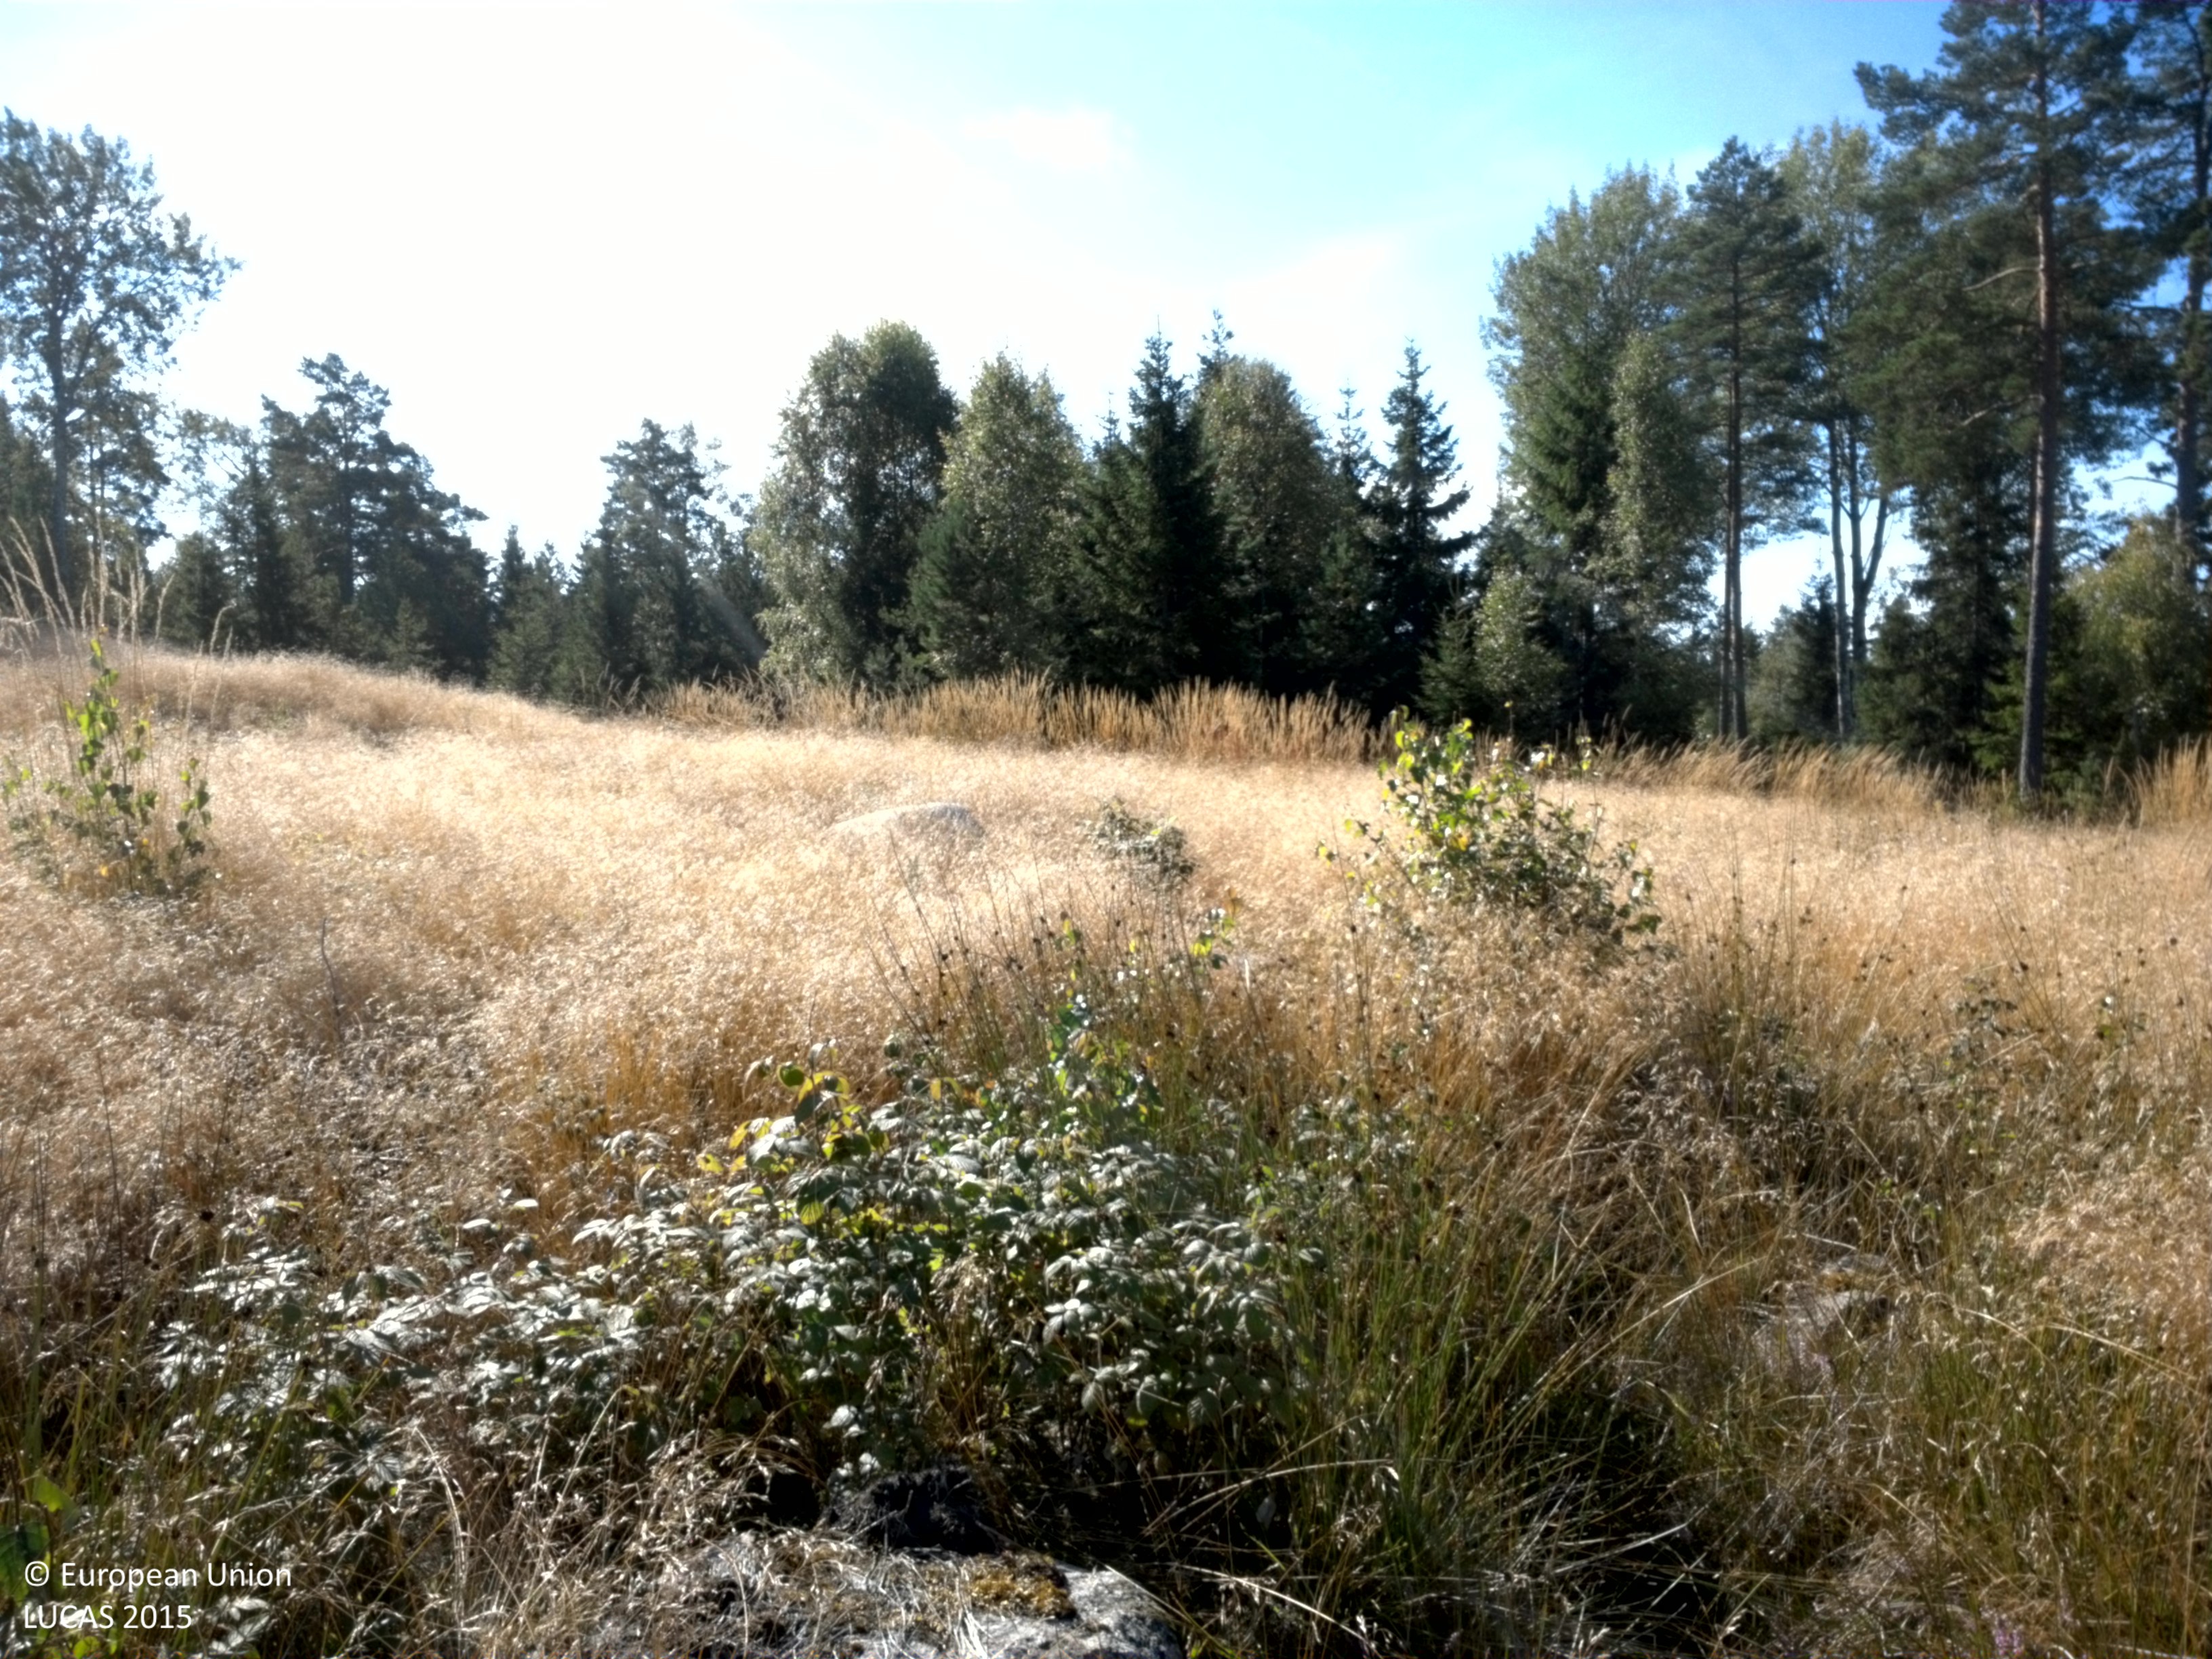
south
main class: Grassland
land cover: Grassland without tree/shrub cover
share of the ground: > 75 %
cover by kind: herbaceous plants 95 %, unconsolidated bare surface 5 %
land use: Forestry
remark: Clear cut
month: August
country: SE
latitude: 59.6079
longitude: 18.6304
